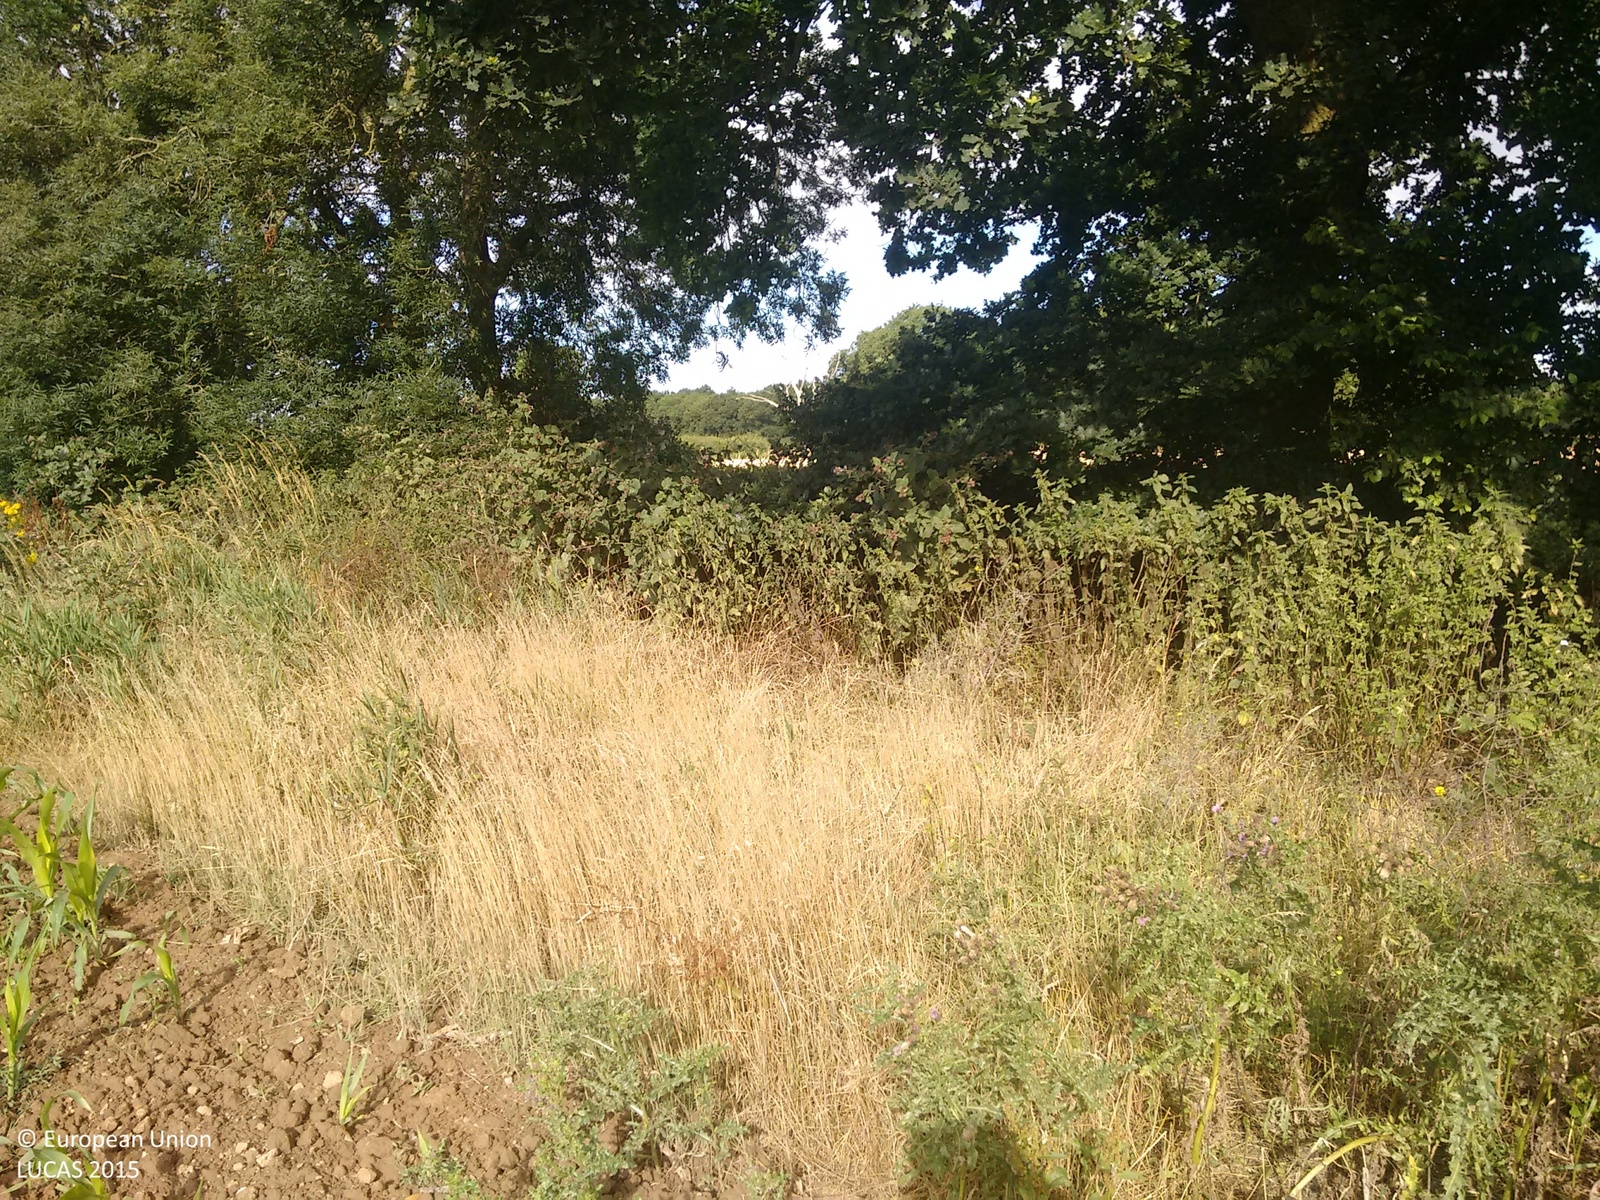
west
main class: Cropland
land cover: Maize
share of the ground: > 75 %
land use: Agriculture (excluding fallow land and kitchen gardens)
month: July
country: GB
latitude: 51.6792
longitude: 0.6160
